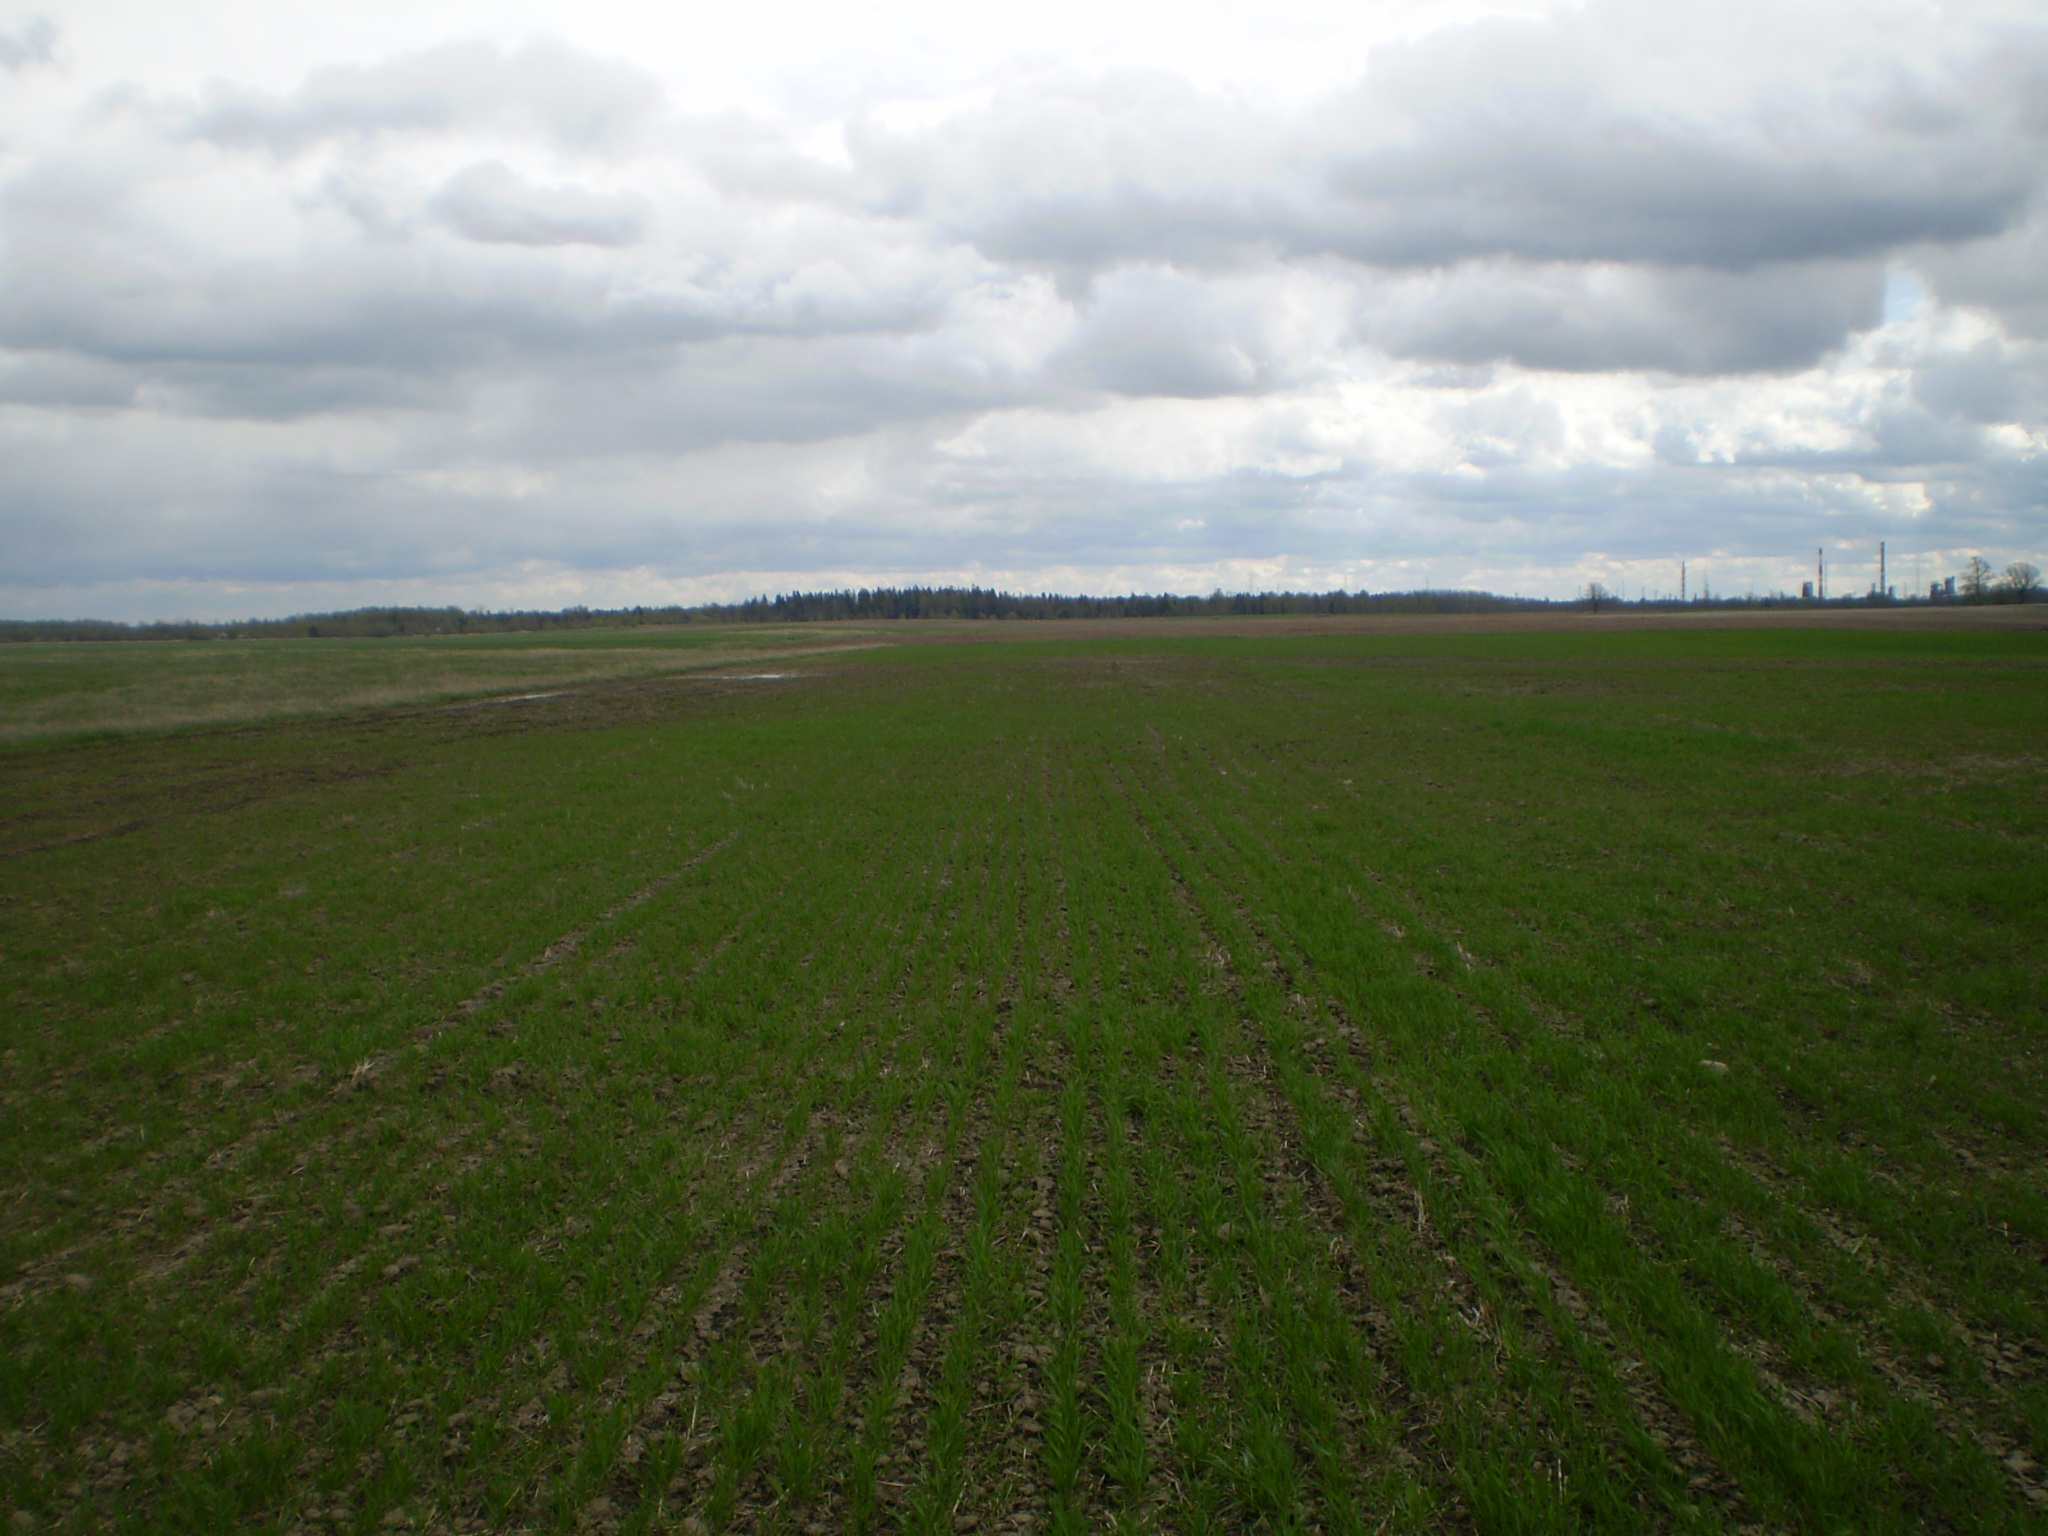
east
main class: Cropland
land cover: Common wheat
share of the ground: 50 - 75 %
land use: Agriculture (excluding fallow land and kitchen gardens)
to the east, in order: Common wheat; Grassland without tree/shrub cover
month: May
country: LT
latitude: 56.4112
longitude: 22.1262
